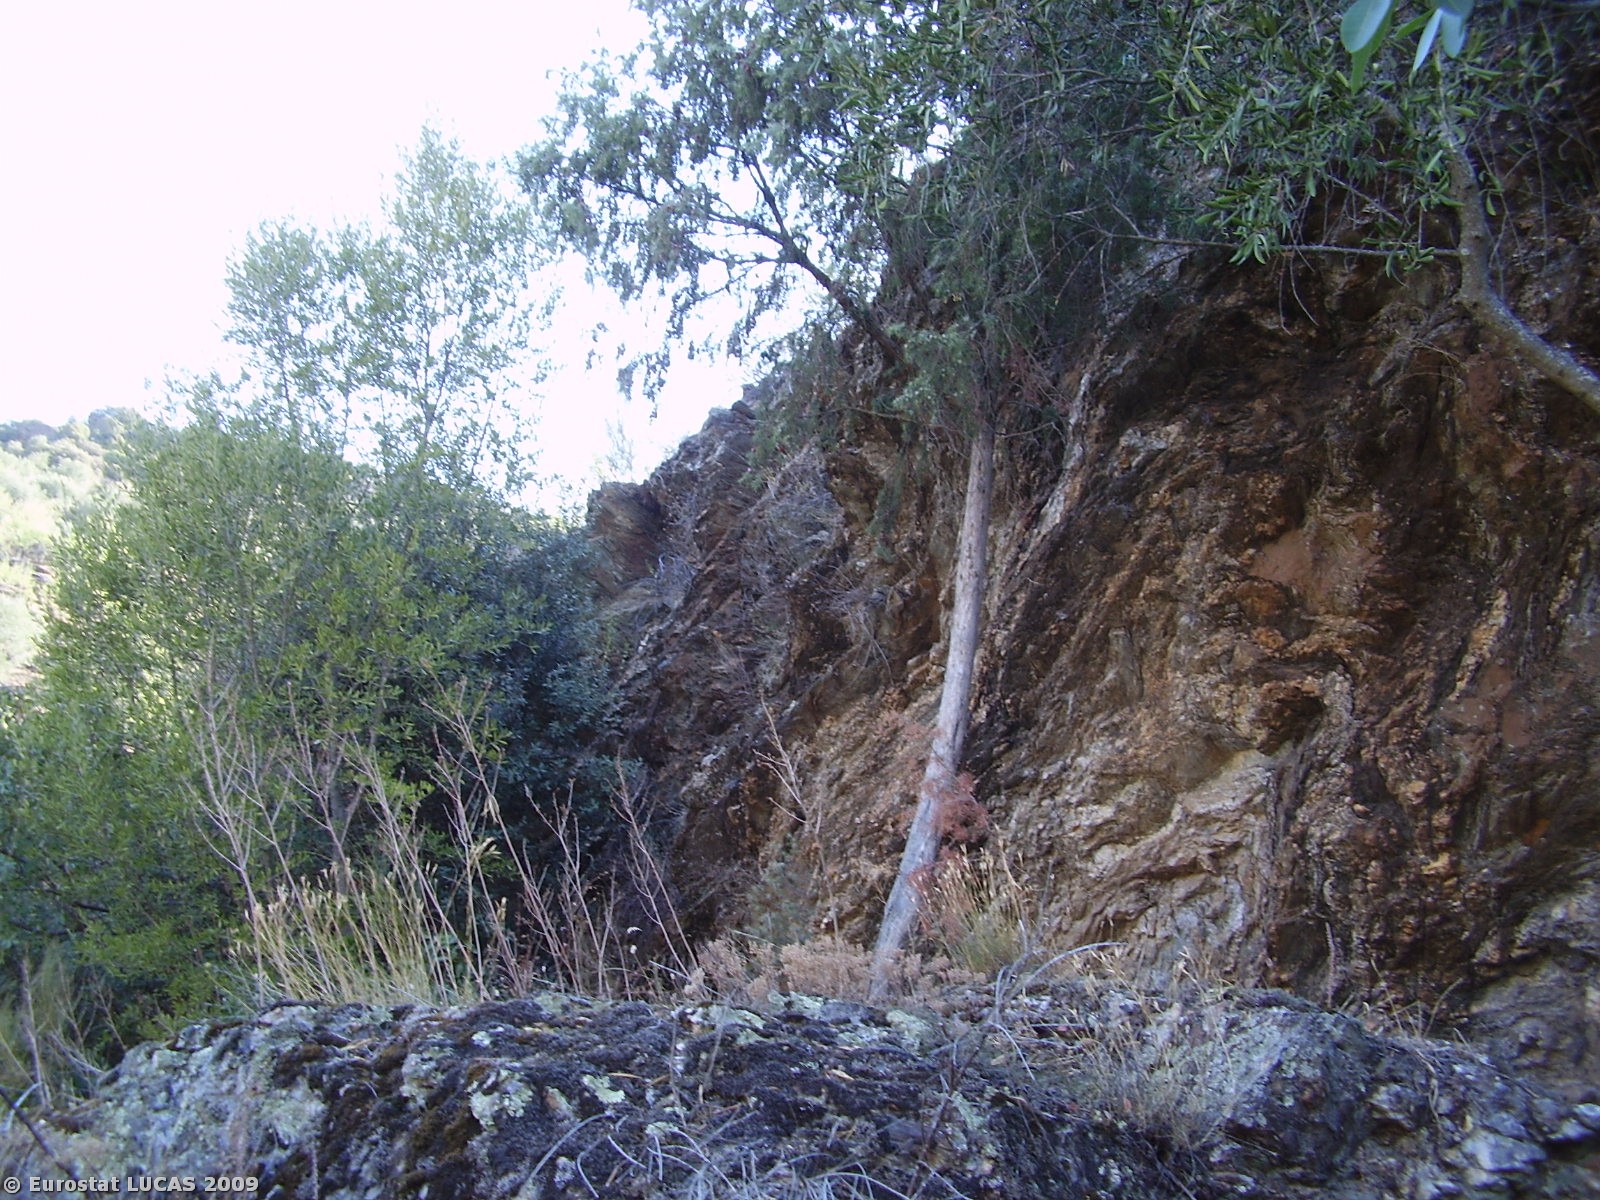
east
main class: Shrubland
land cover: Shrubland with sparse tree cover
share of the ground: > 75 %
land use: Fallow land
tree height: > 5 m
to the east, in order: Shrubland with sparse tree cover; Nuts trees; Tracks; Shrubland with sparse tree cover; Olive groves; Rock outcrops; Broadleaved woodland; Tracks; Olive groves
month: August
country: PT
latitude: 41.3271
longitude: -6.8226
